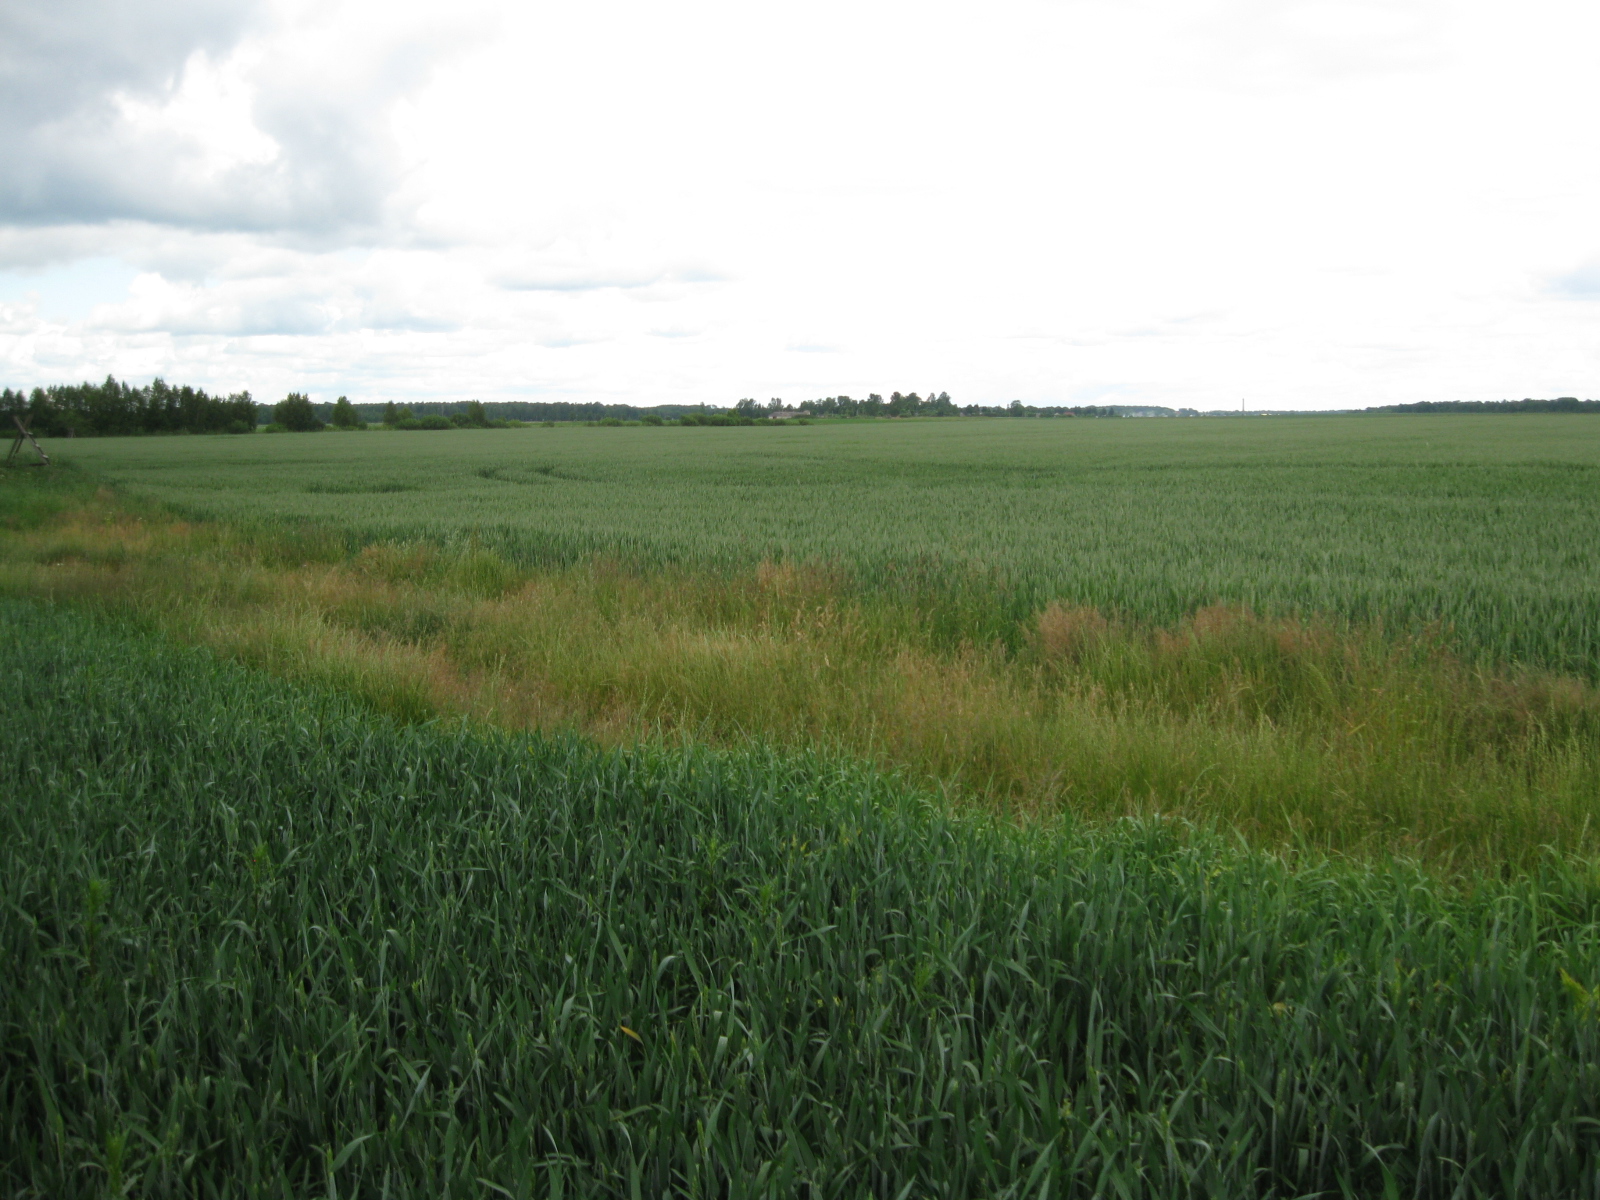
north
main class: Cropland
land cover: Common wheat
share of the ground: > 75 %
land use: Agriculture (excluding fallow land and kitchen gardens)
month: June
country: LT
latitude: 55.3090
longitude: 24.1298
